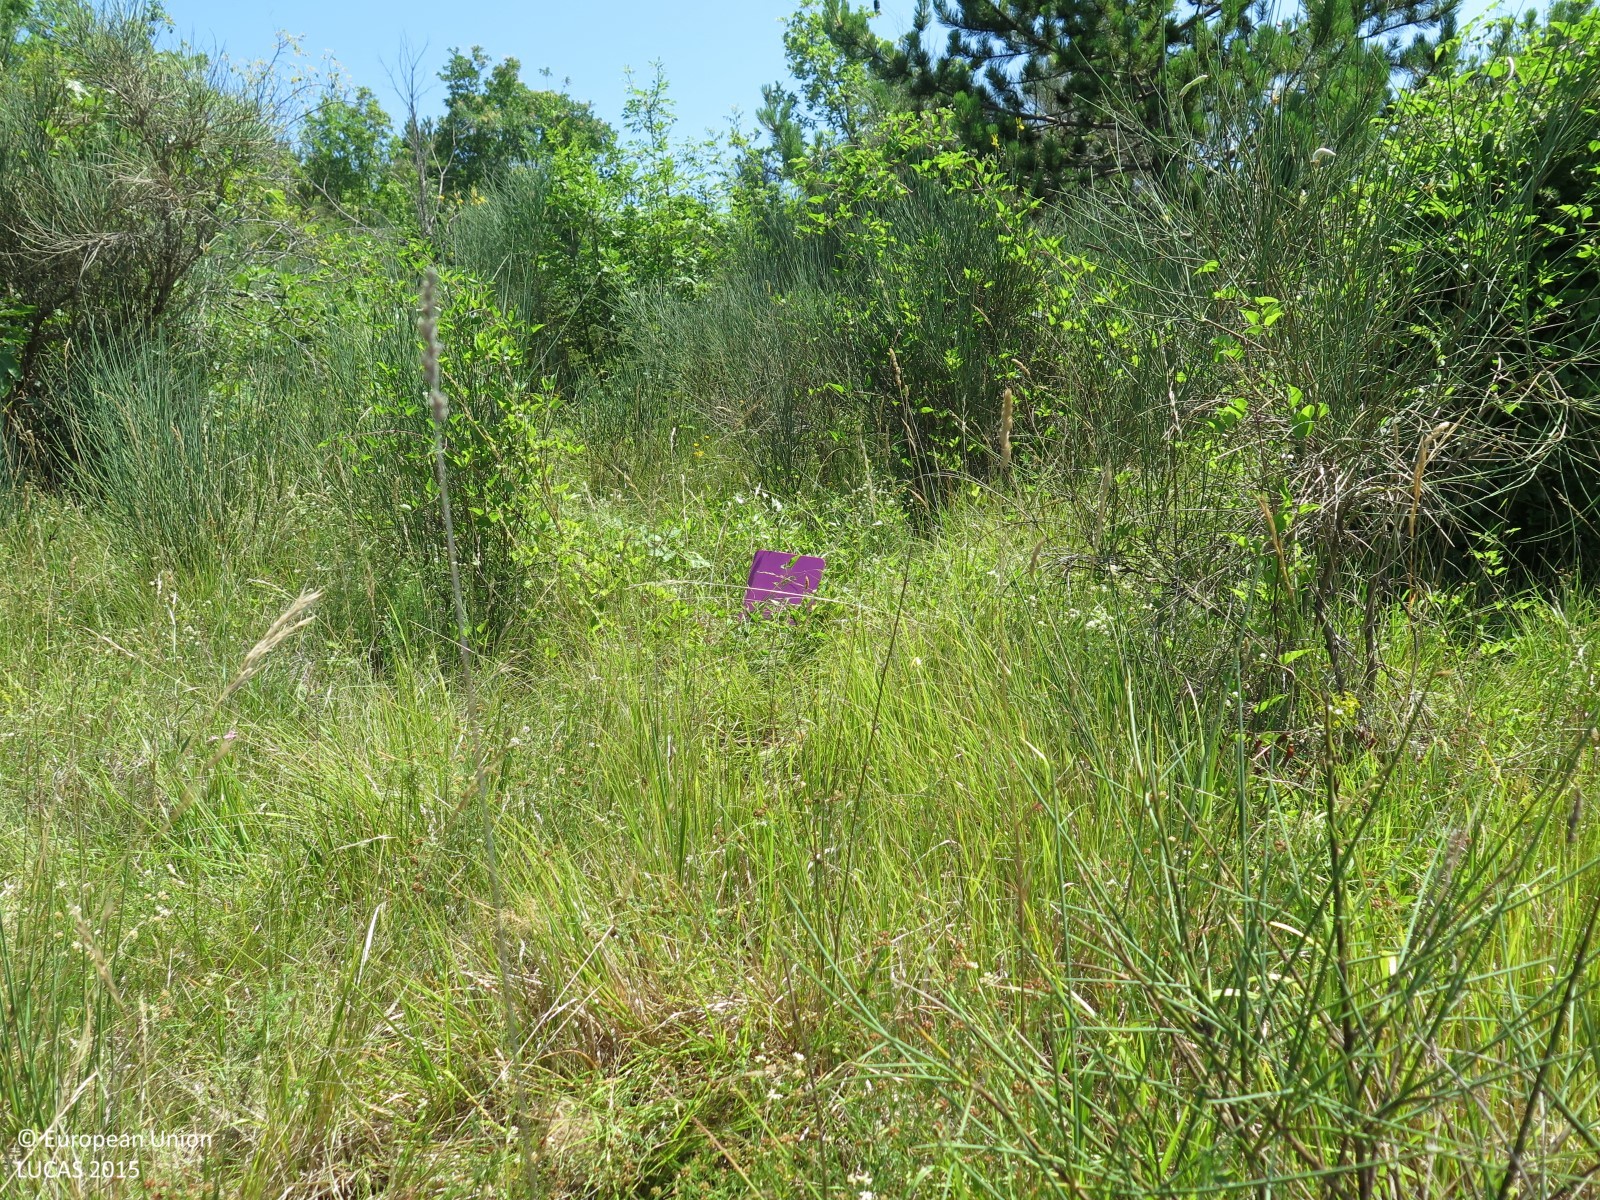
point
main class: Woodland
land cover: Other mixed woodland
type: mesophytic deciduous forest
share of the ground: > 75 %
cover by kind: broadleaved forest trees 65 %, coniferous forest trees 25 %, shrubs 5 %, herbaceous plants 5 %
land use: Semi-natural and natural areas not in use
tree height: < 5 m
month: July
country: HR
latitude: 45.3671
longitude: 13.7105
